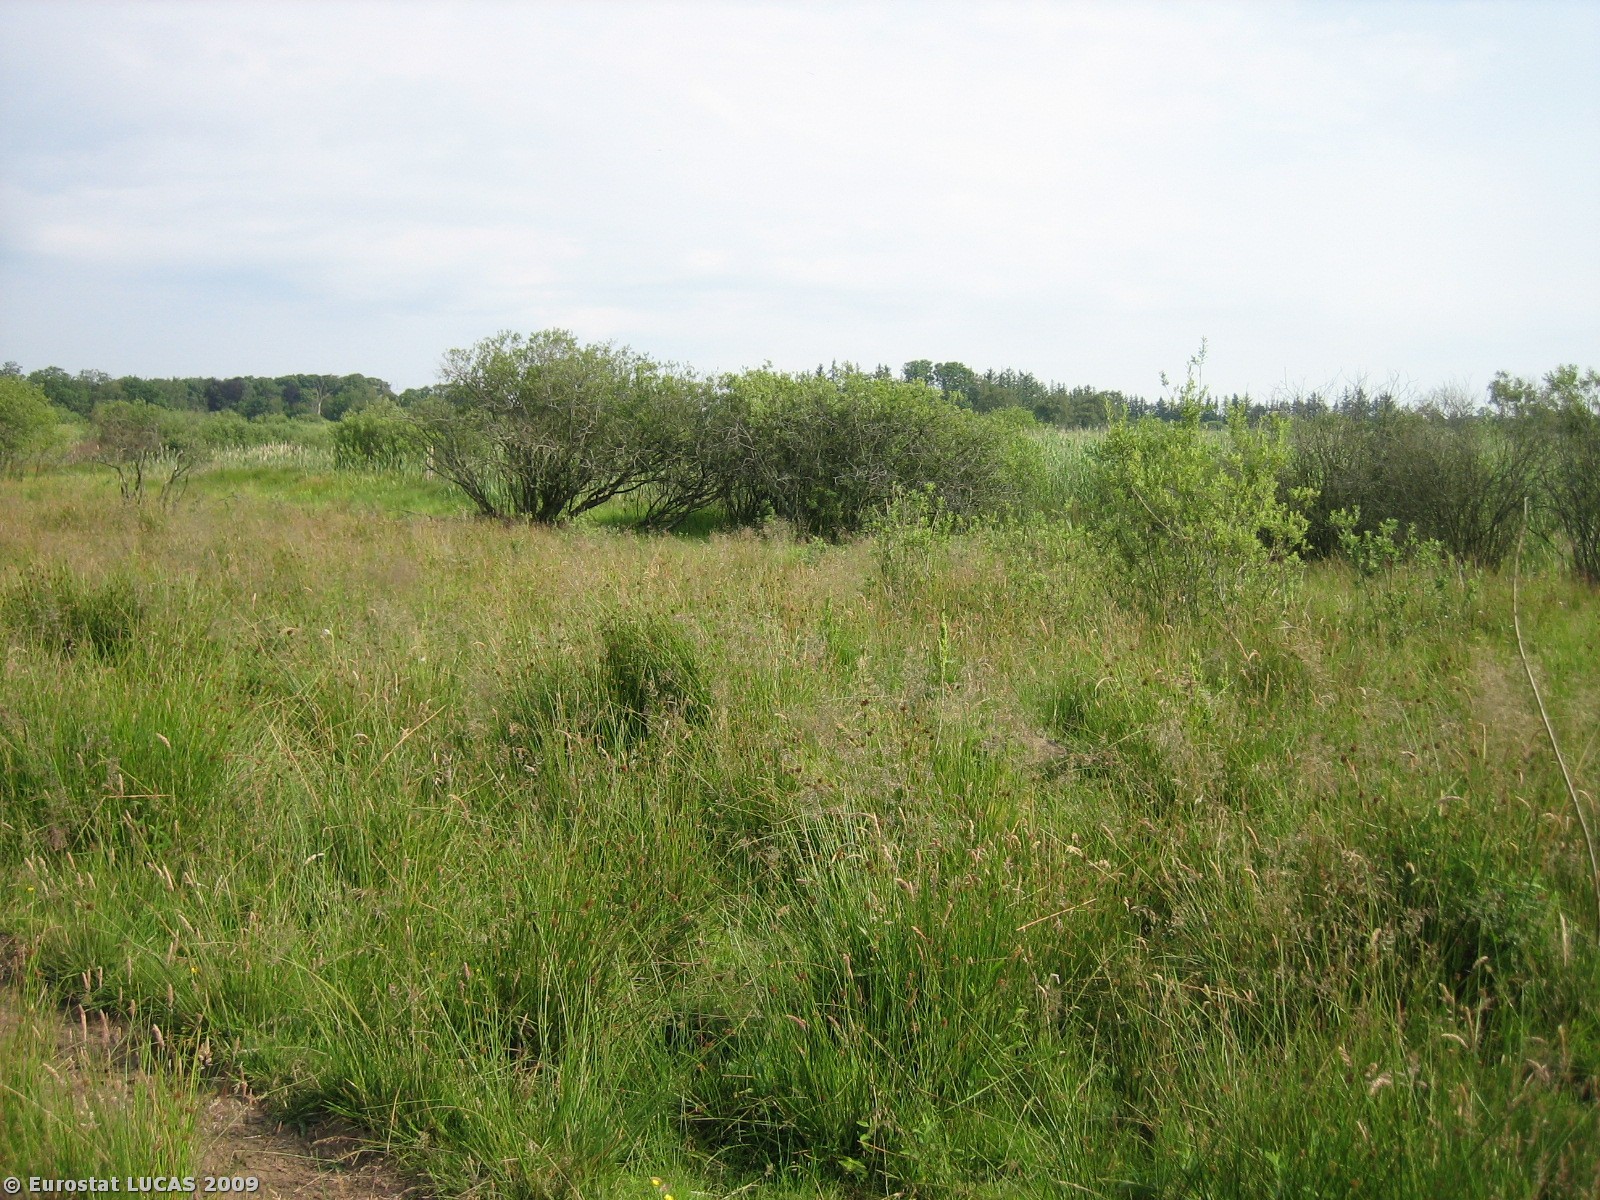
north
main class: Grassland
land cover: Grassland without tree/shrub cover
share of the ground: > 75 %
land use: Unused
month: July
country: DK
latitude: 55.3018
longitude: 8.8511
